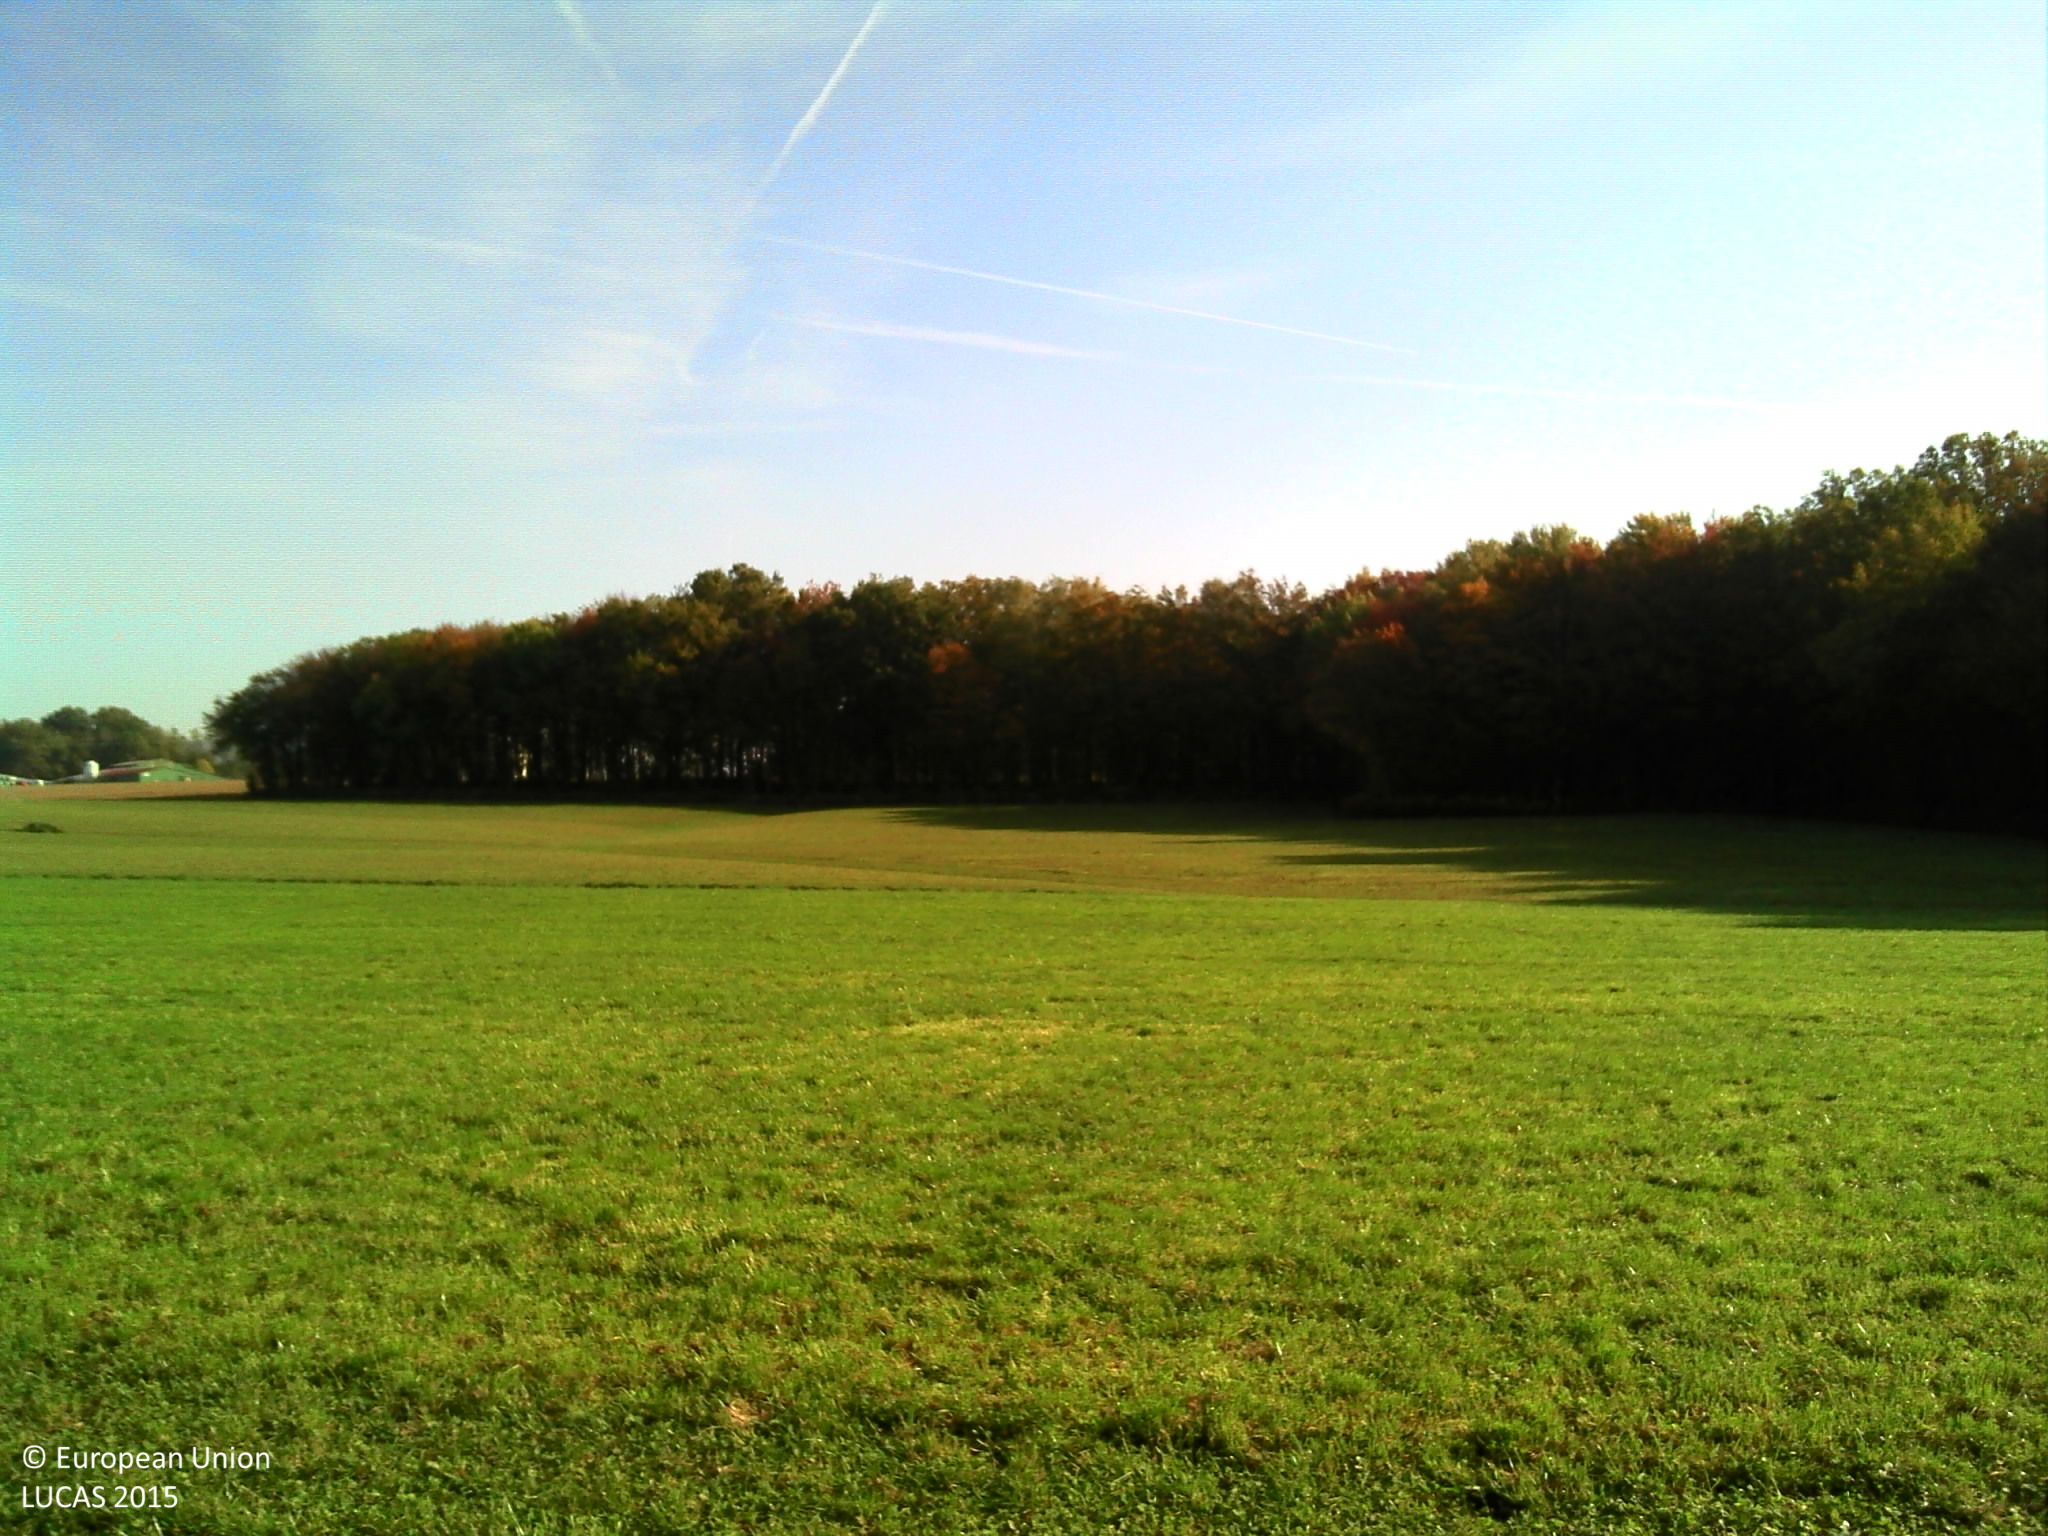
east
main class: Cropland
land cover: Temporary grasslands
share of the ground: > 75 %
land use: Agriculture (excluding fallow land and kitchen gardens)
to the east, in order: Temporary grasslands; Ditches and canals; Temporary grasslands; Ditches and canals; Broadleaved woodland
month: October
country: FR
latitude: 46.0668
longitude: 5.2846
